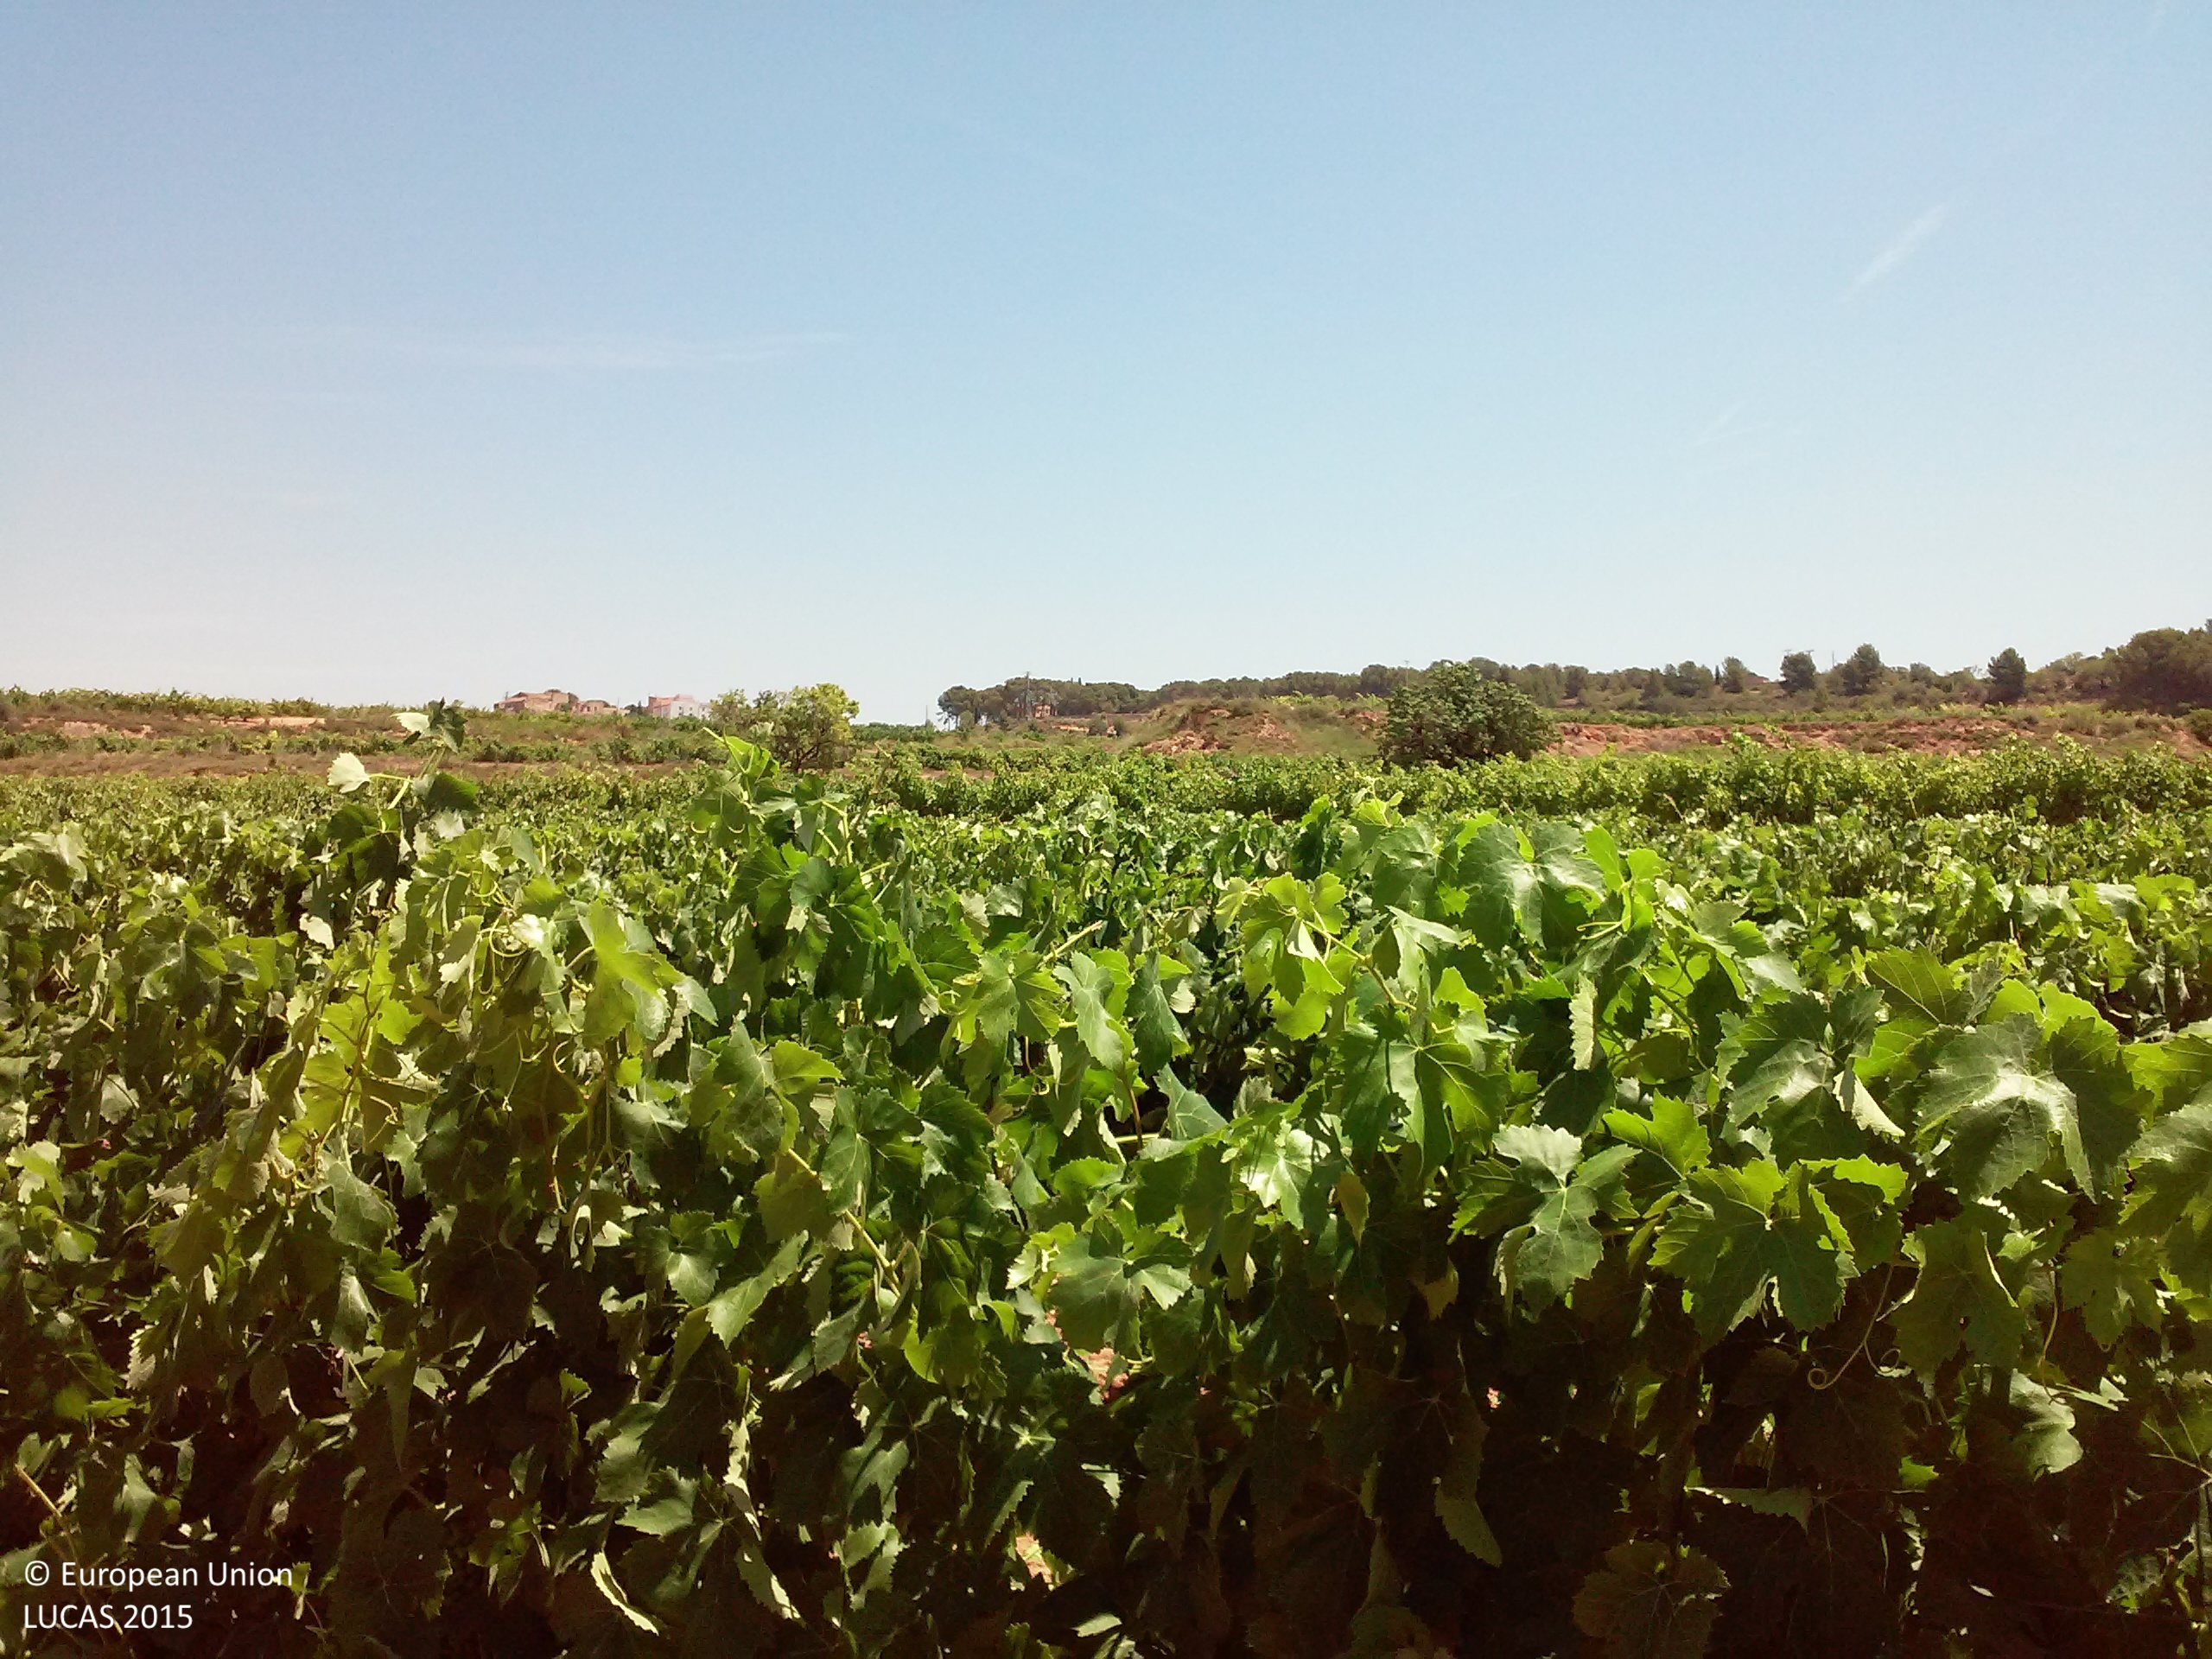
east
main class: Cropland
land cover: Vineyards
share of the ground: 25 - 50 %
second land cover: Other bare soil
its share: > 75 %
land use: Agriculture (excluding fallow land and kitchen gardens)
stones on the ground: 25 - 50 %
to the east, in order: Vineyards; Other bare soil; Grass margins; Vineyards; Dry stone walls; Grassland with sparse tree/shrub cover; Tracks; Vineyards; Tracks; Grassland with sparse tree/shrub cover; Vineyards; Tracks; Vineyards; Grass margins; Vineyards
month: June
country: ES
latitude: 41.2592
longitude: 1.2682
